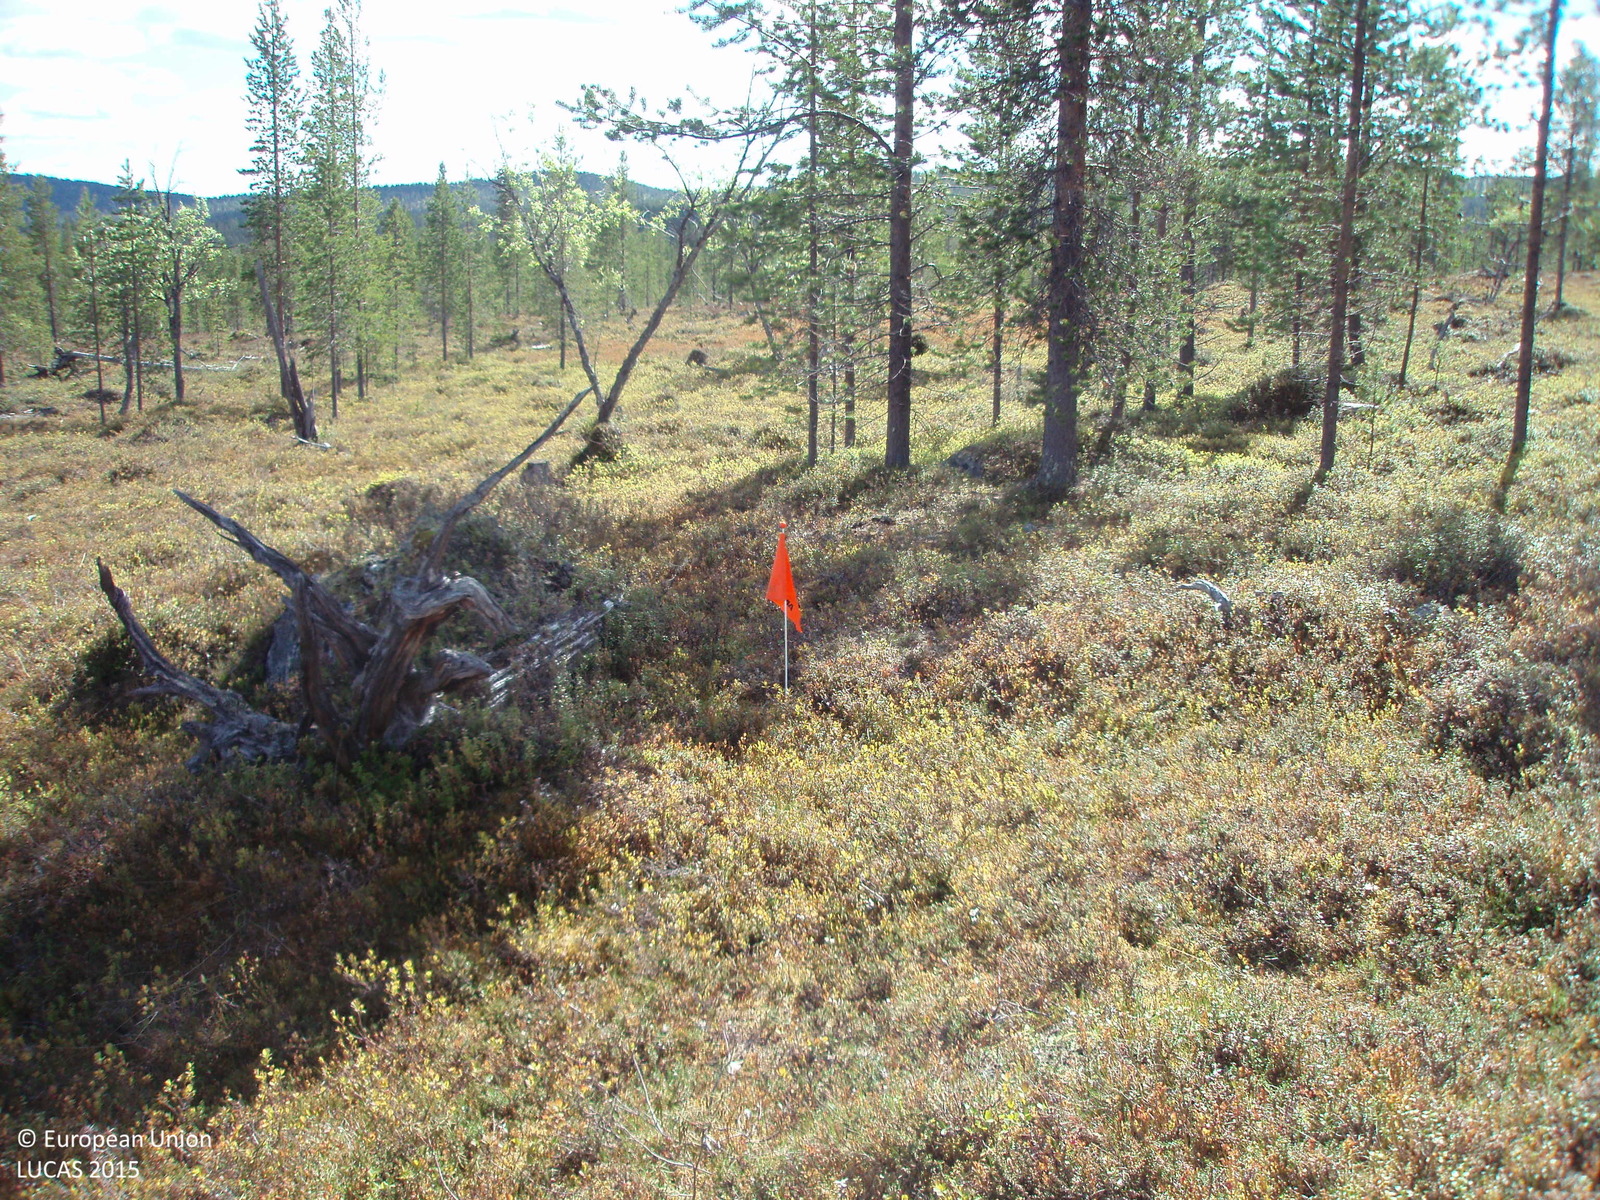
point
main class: Woodland
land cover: Pine dominated coniferous woodland
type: boreal forest
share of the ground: 25 - 50 %
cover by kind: shrubs 50 %, coniferous forest trees 35 %, lichens and mosses 10 %, broadleaved forest trees 5 %
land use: Forestry
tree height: > 5 m
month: June
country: FI
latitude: 68.6269
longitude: 28.0168
